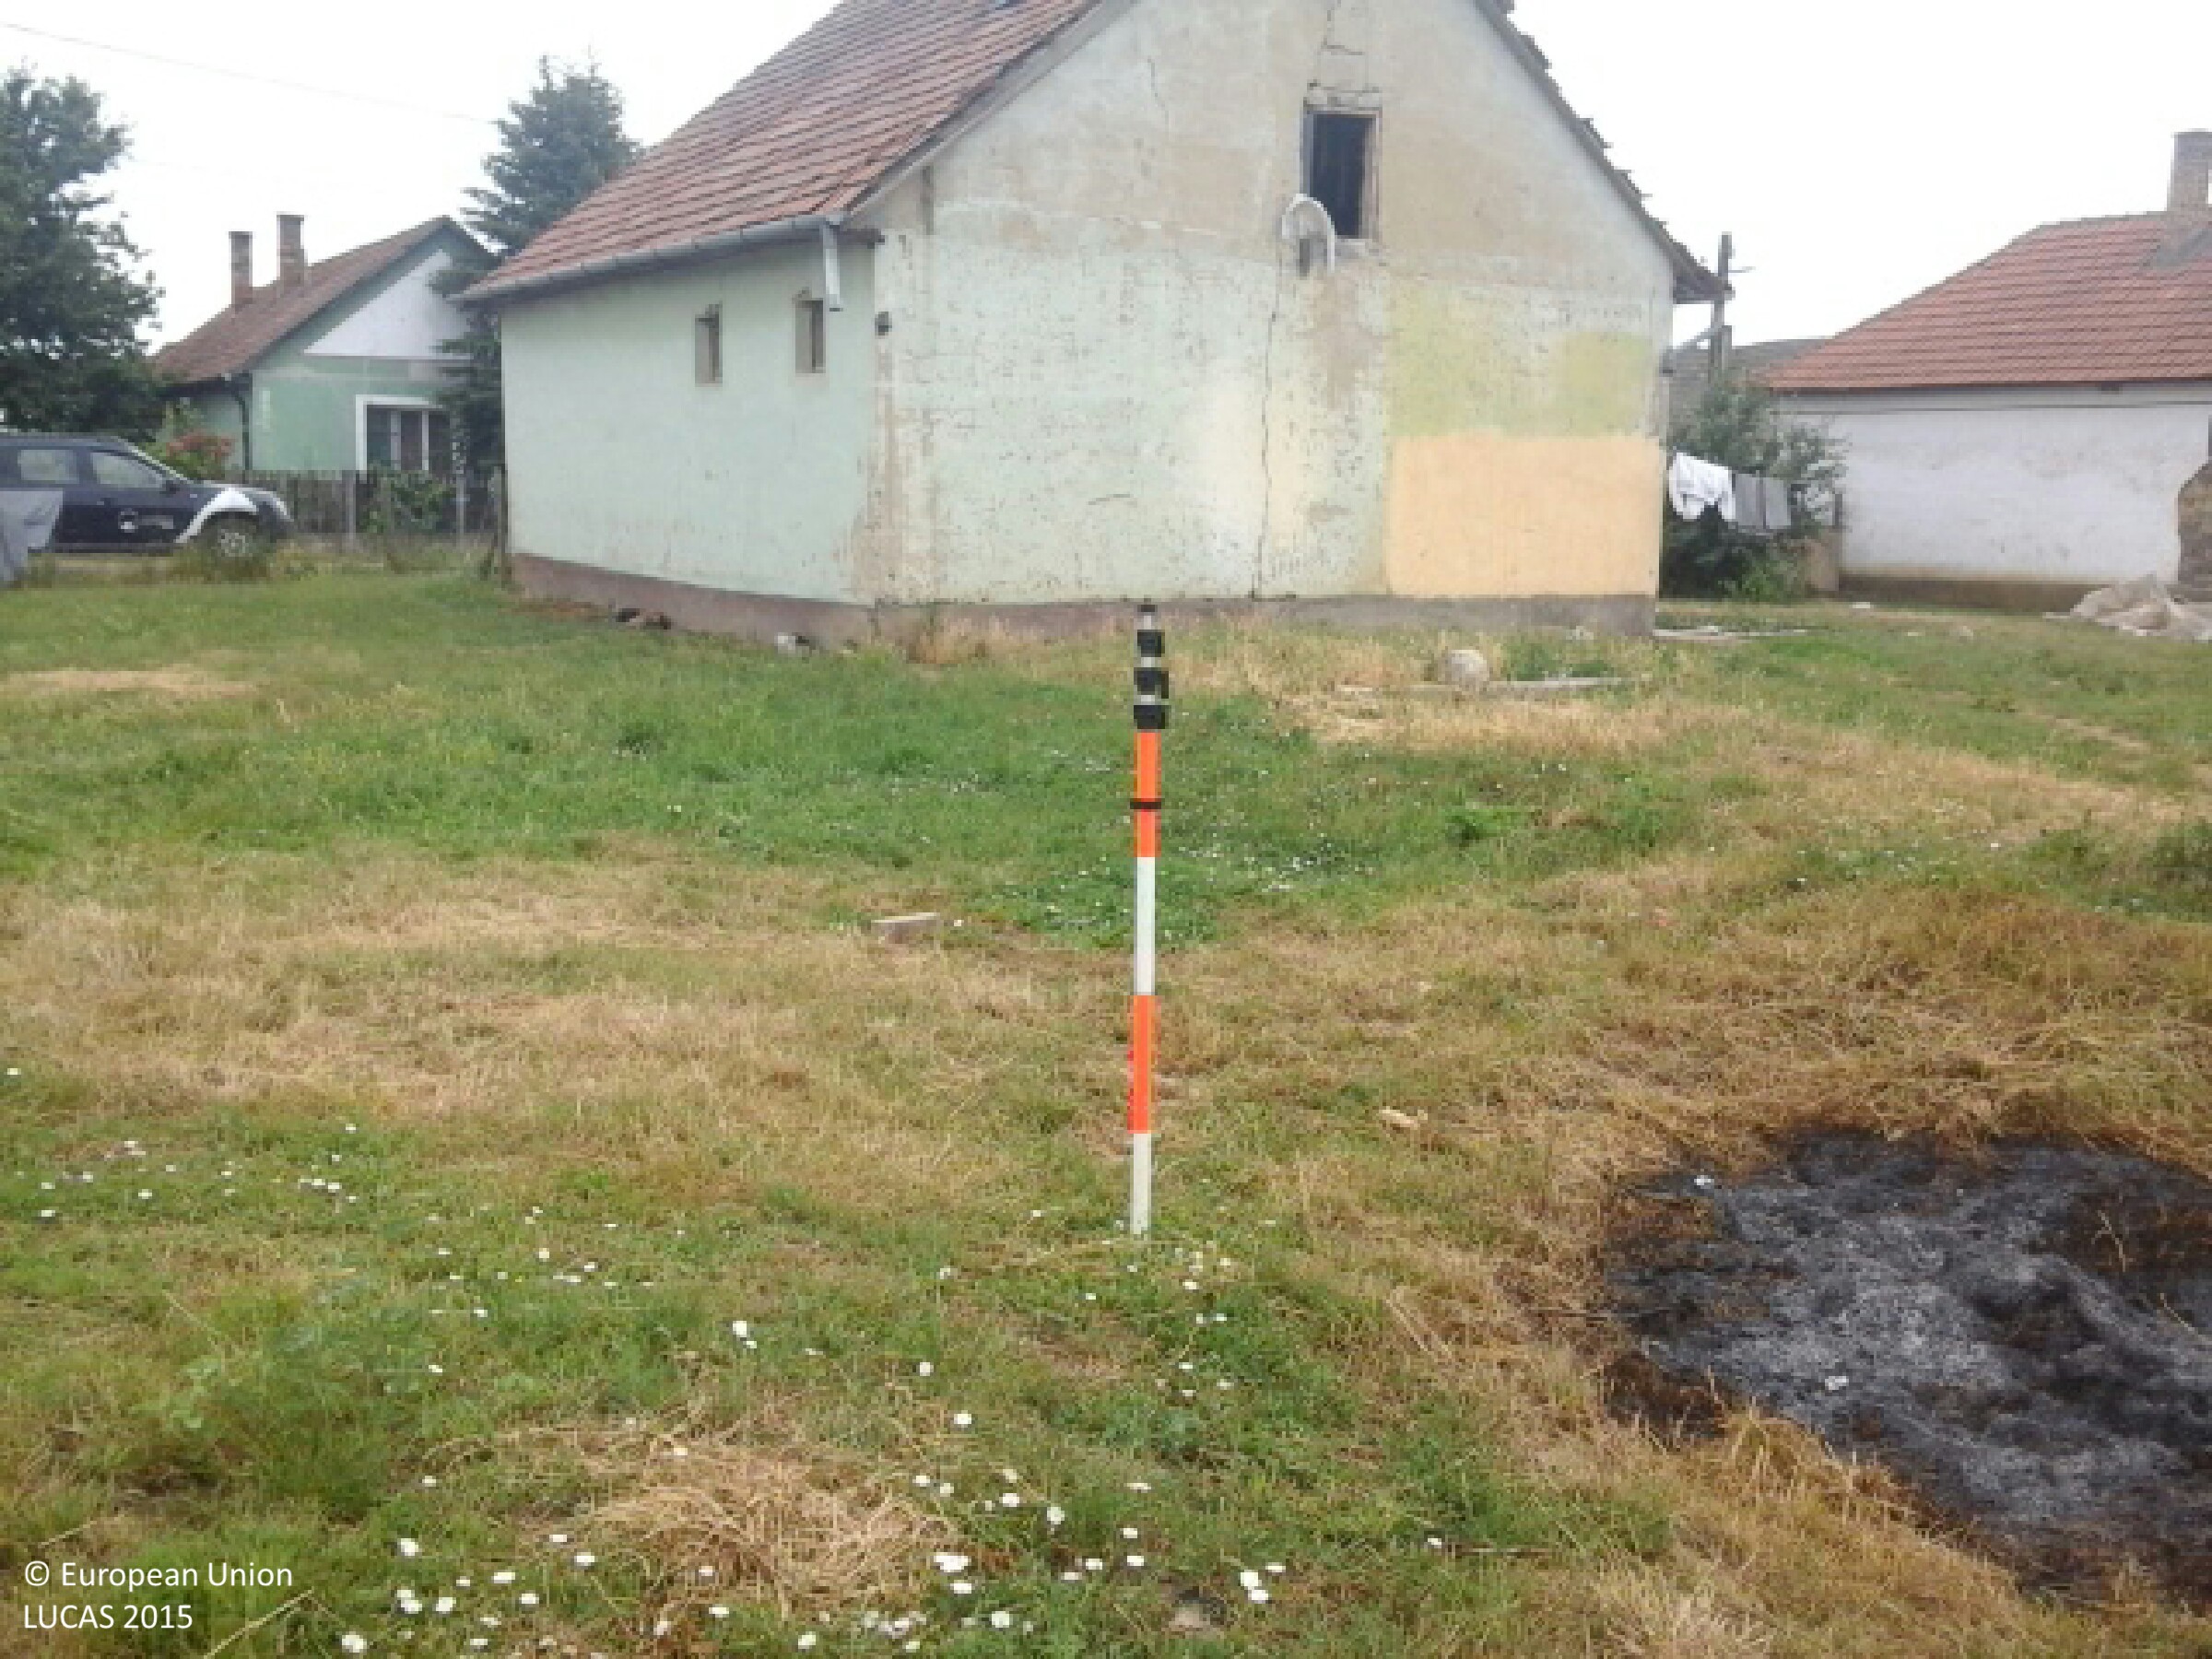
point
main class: Grassland
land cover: Grassland without tree/shrub cover
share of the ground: > 75 %
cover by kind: herbaceous plants 100 %
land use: Residential
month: June
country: HU
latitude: 48.0240
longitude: 21.4555
